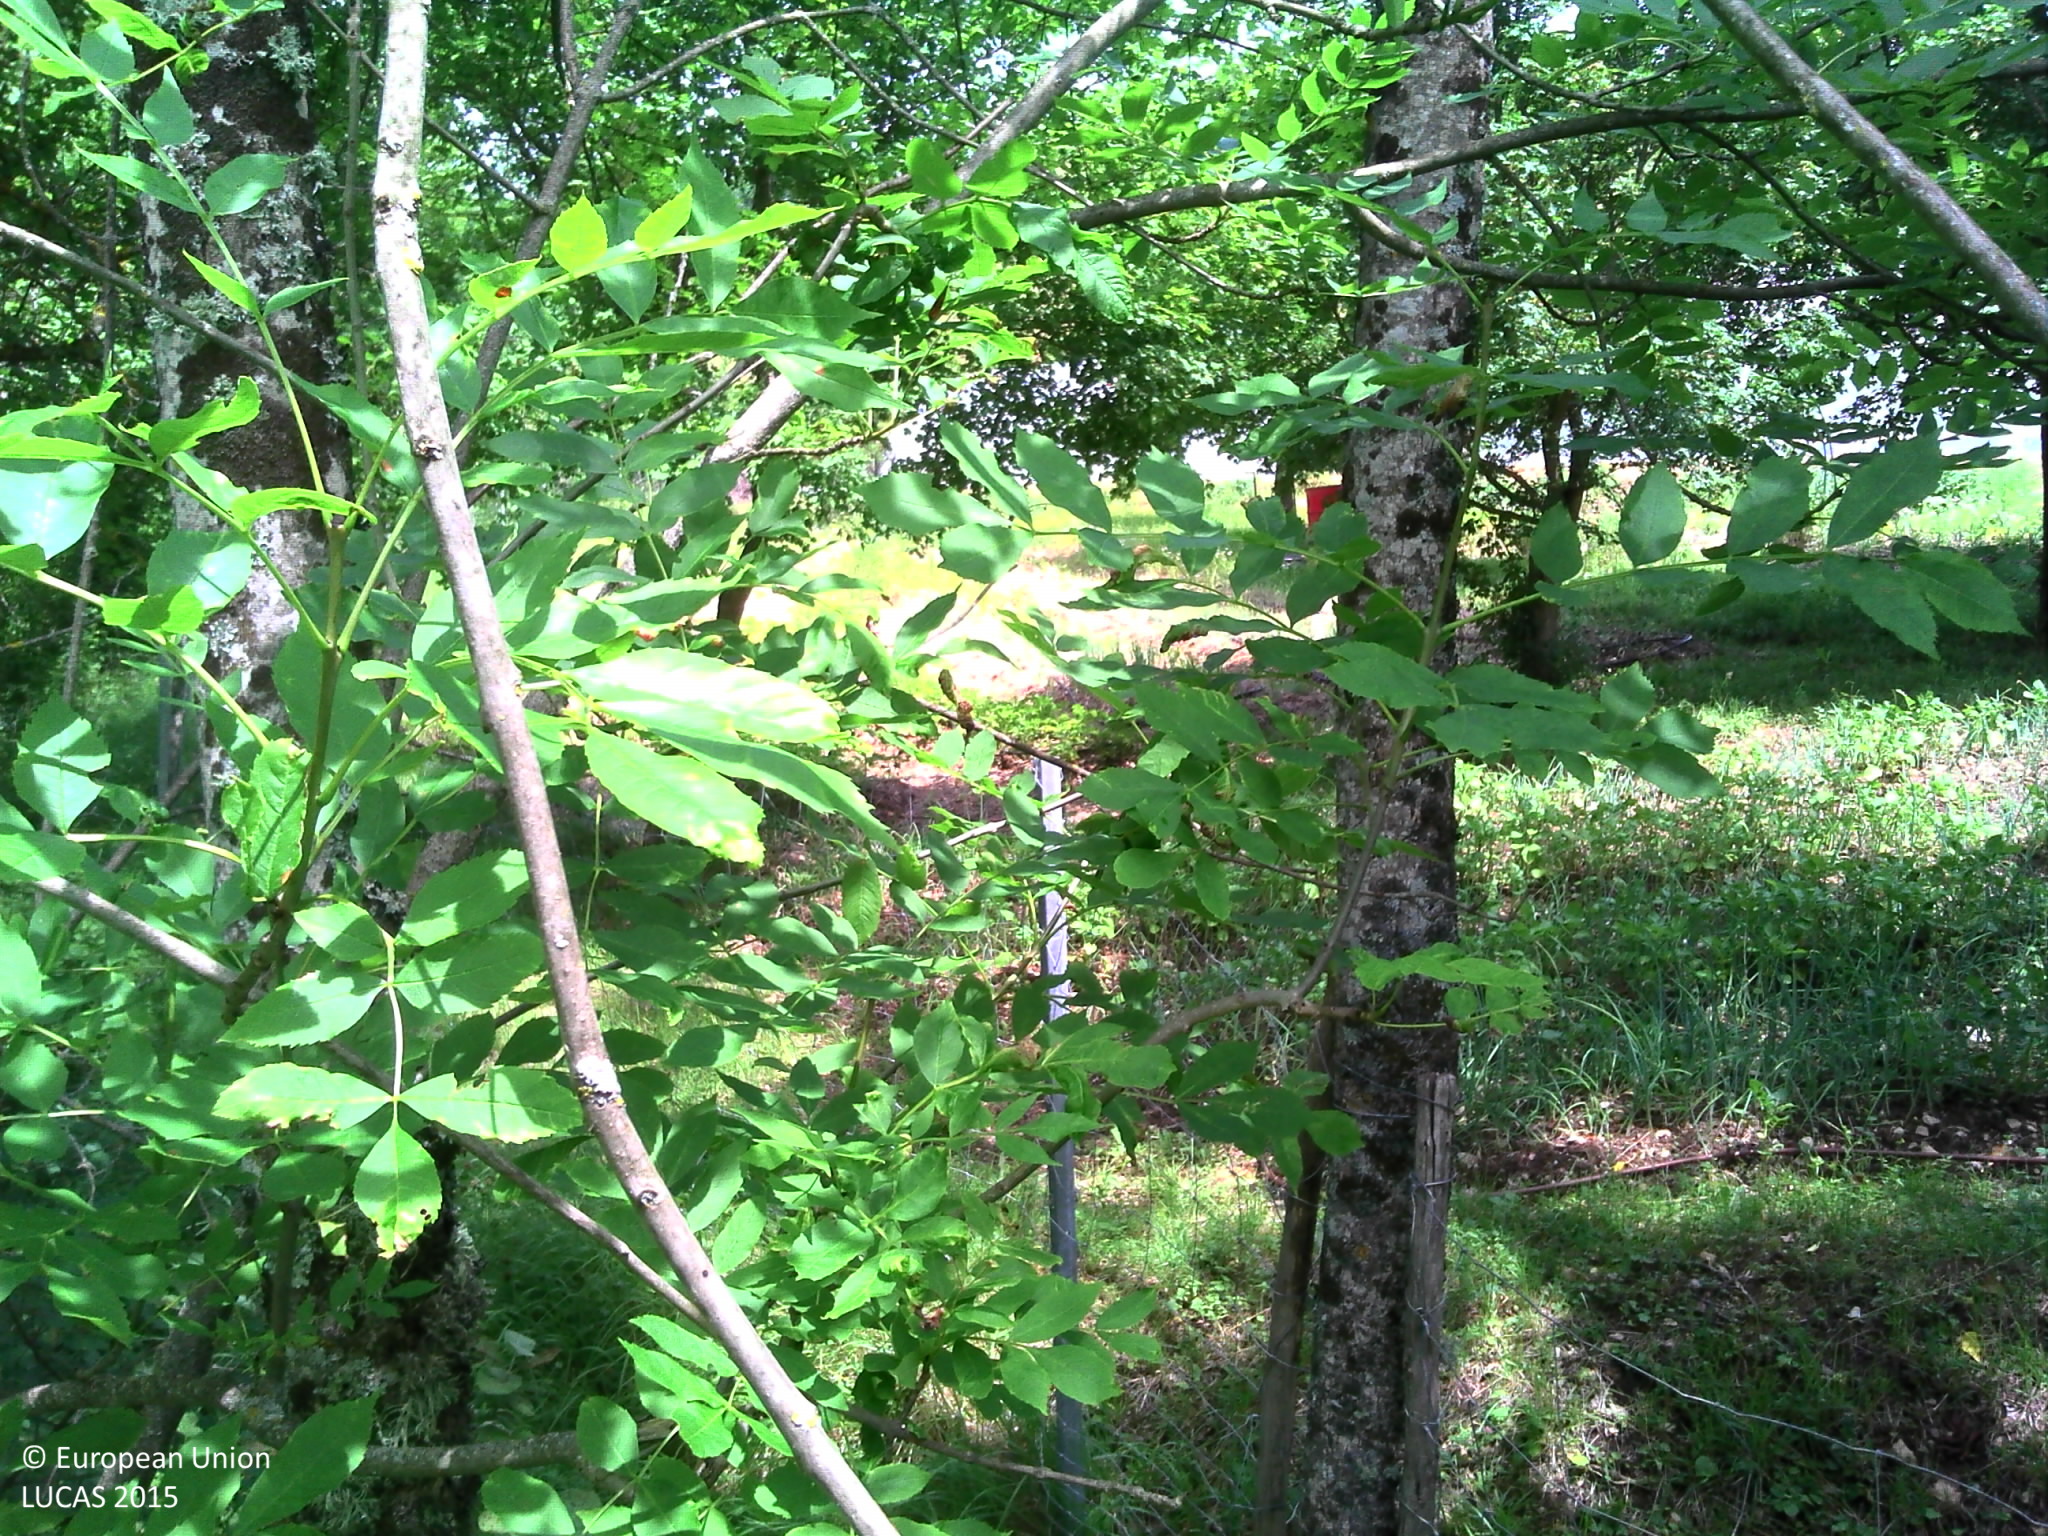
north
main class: Woodland
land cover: Broadleaved woodland
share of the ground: > 75 %
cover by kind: herbaceous plants 85 %, broadleaved forest trees 10 %, shrubs 5 %
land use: Agriculture (excluding fallow land and kitchen gardens)
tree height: > 5 m
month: June
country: FR
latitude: 44.7462
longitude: 5.2195
